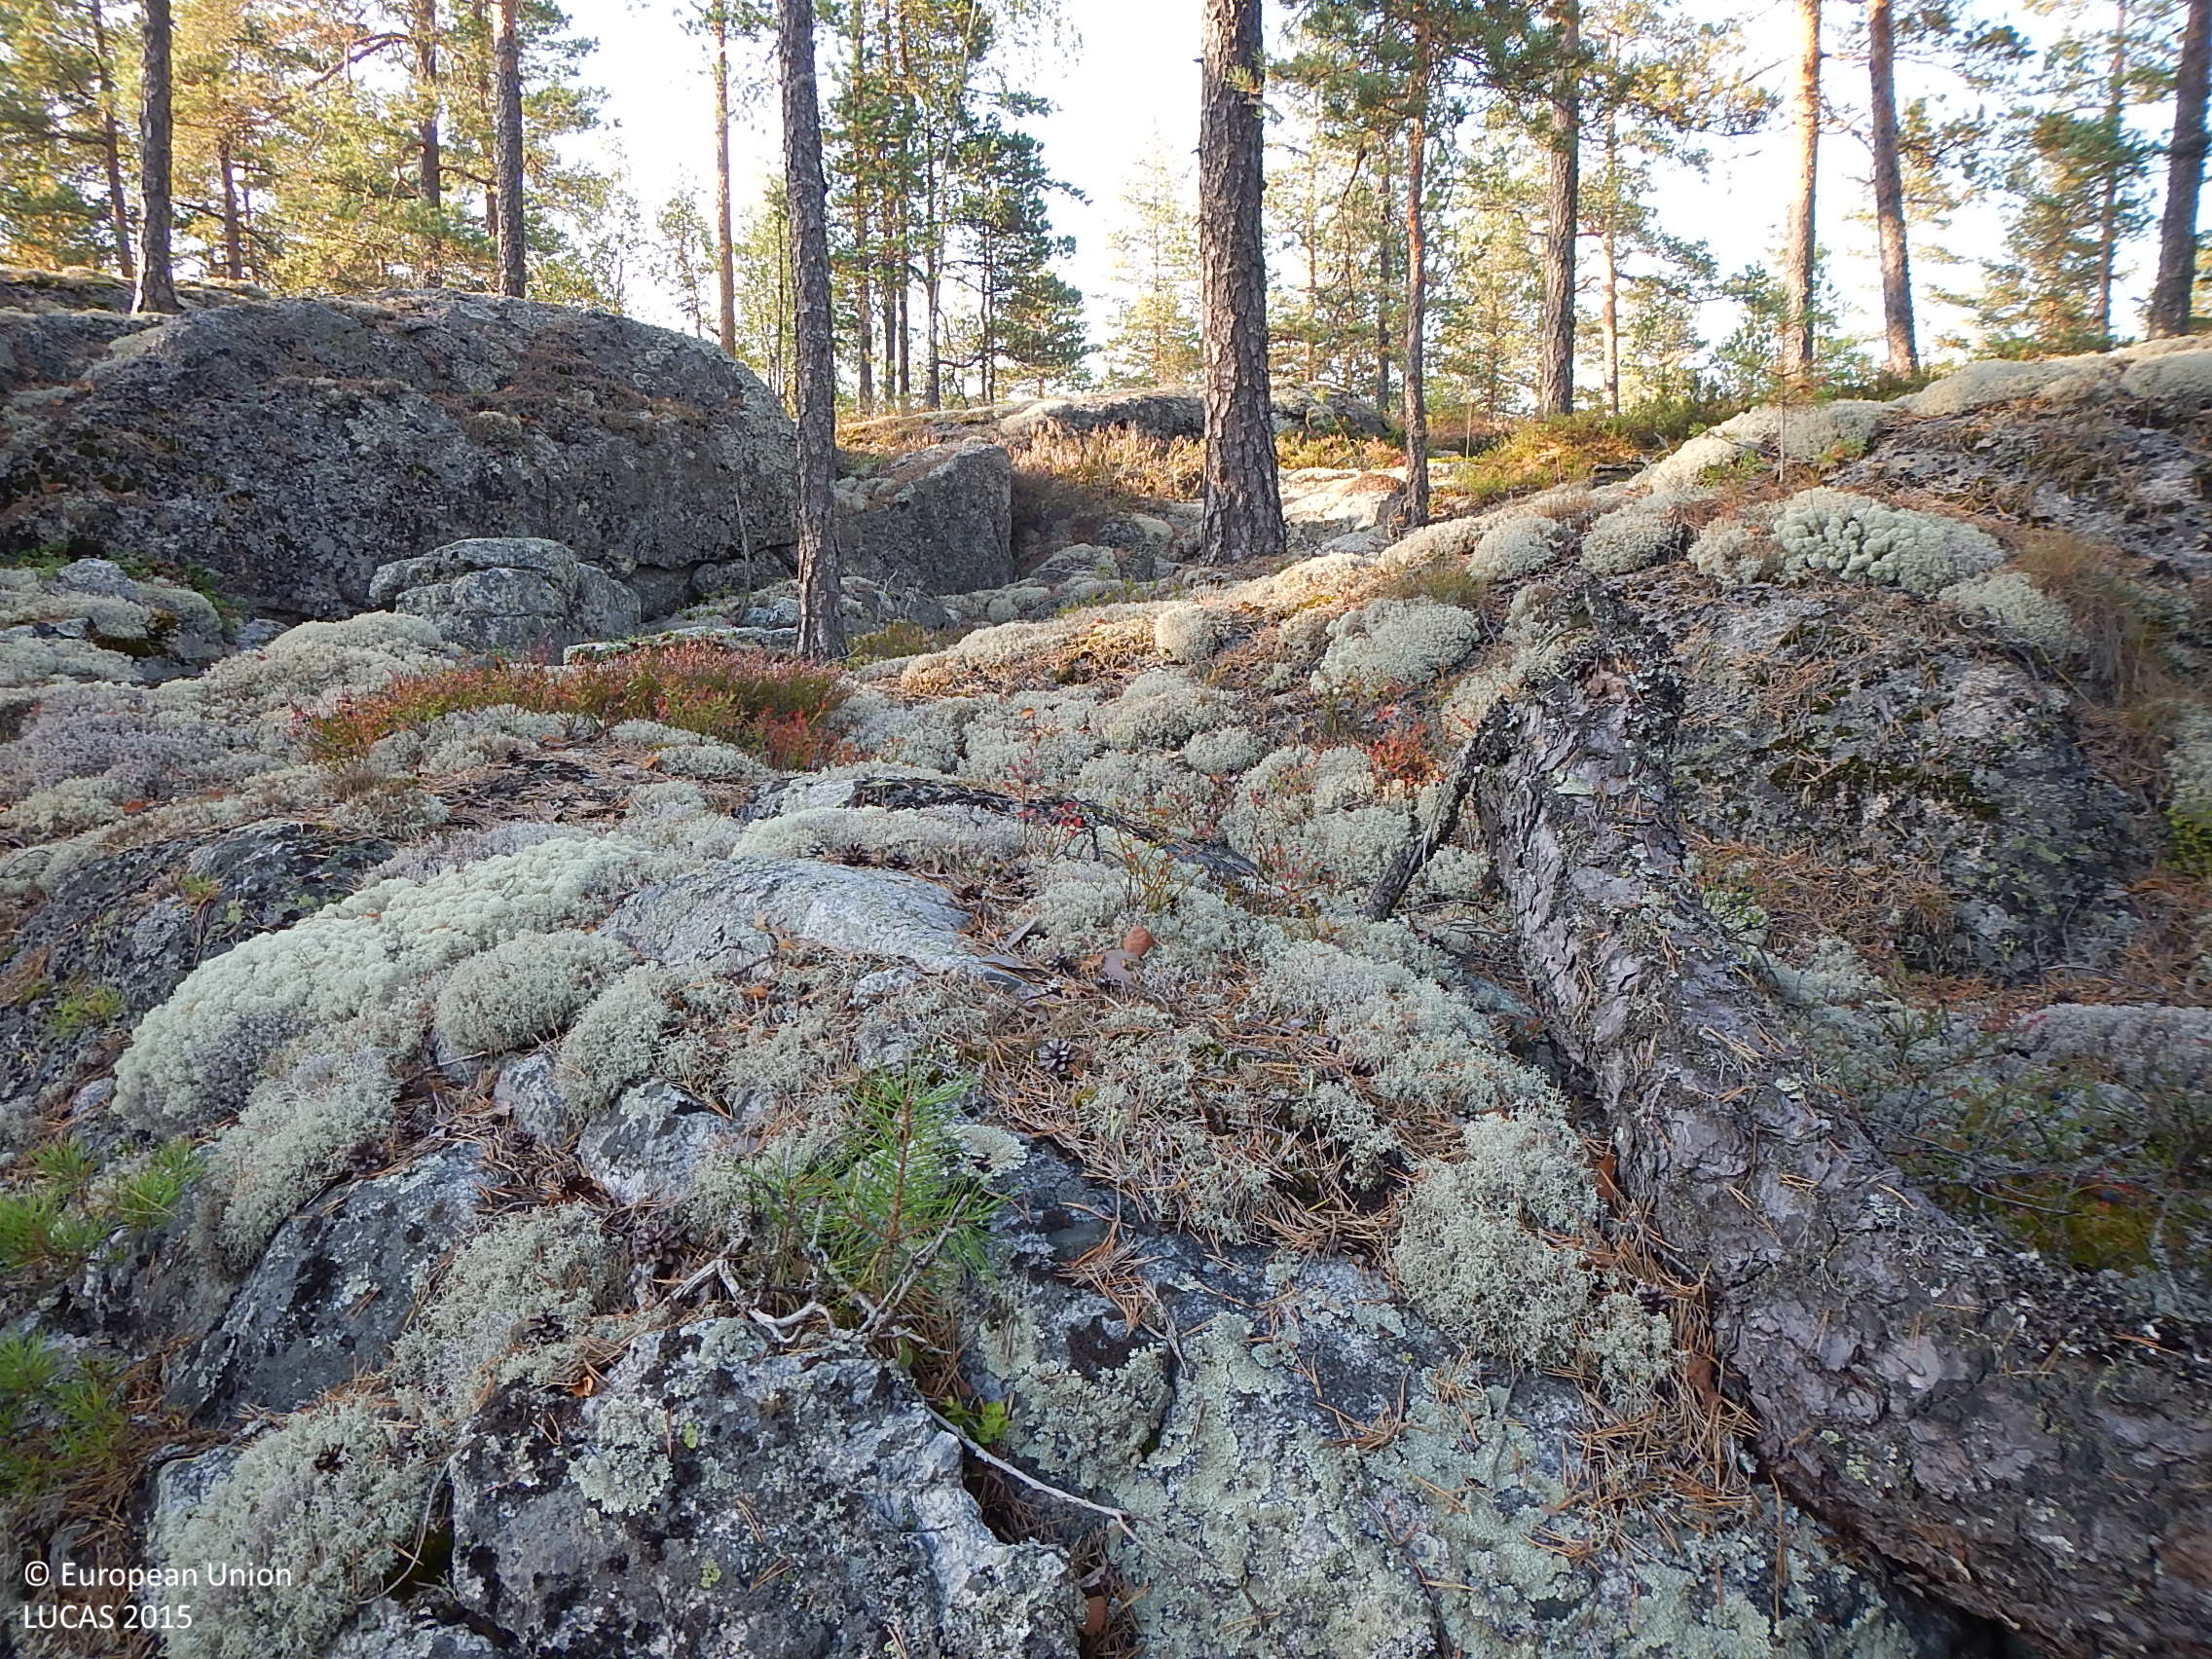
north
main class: Woodland
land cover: Pine dominated coniferous woodland
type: boreal forest
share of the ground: 25 - 50 %
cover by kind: coniferous forest trees 40 %, lichens and mosses 40 %, shrubs 10 %, consolidated bare surface 10 %
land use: Forestry
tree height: > 5 m
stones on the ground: < 10 %
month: September
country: FI
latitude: 61.6371
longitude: 22.6508
